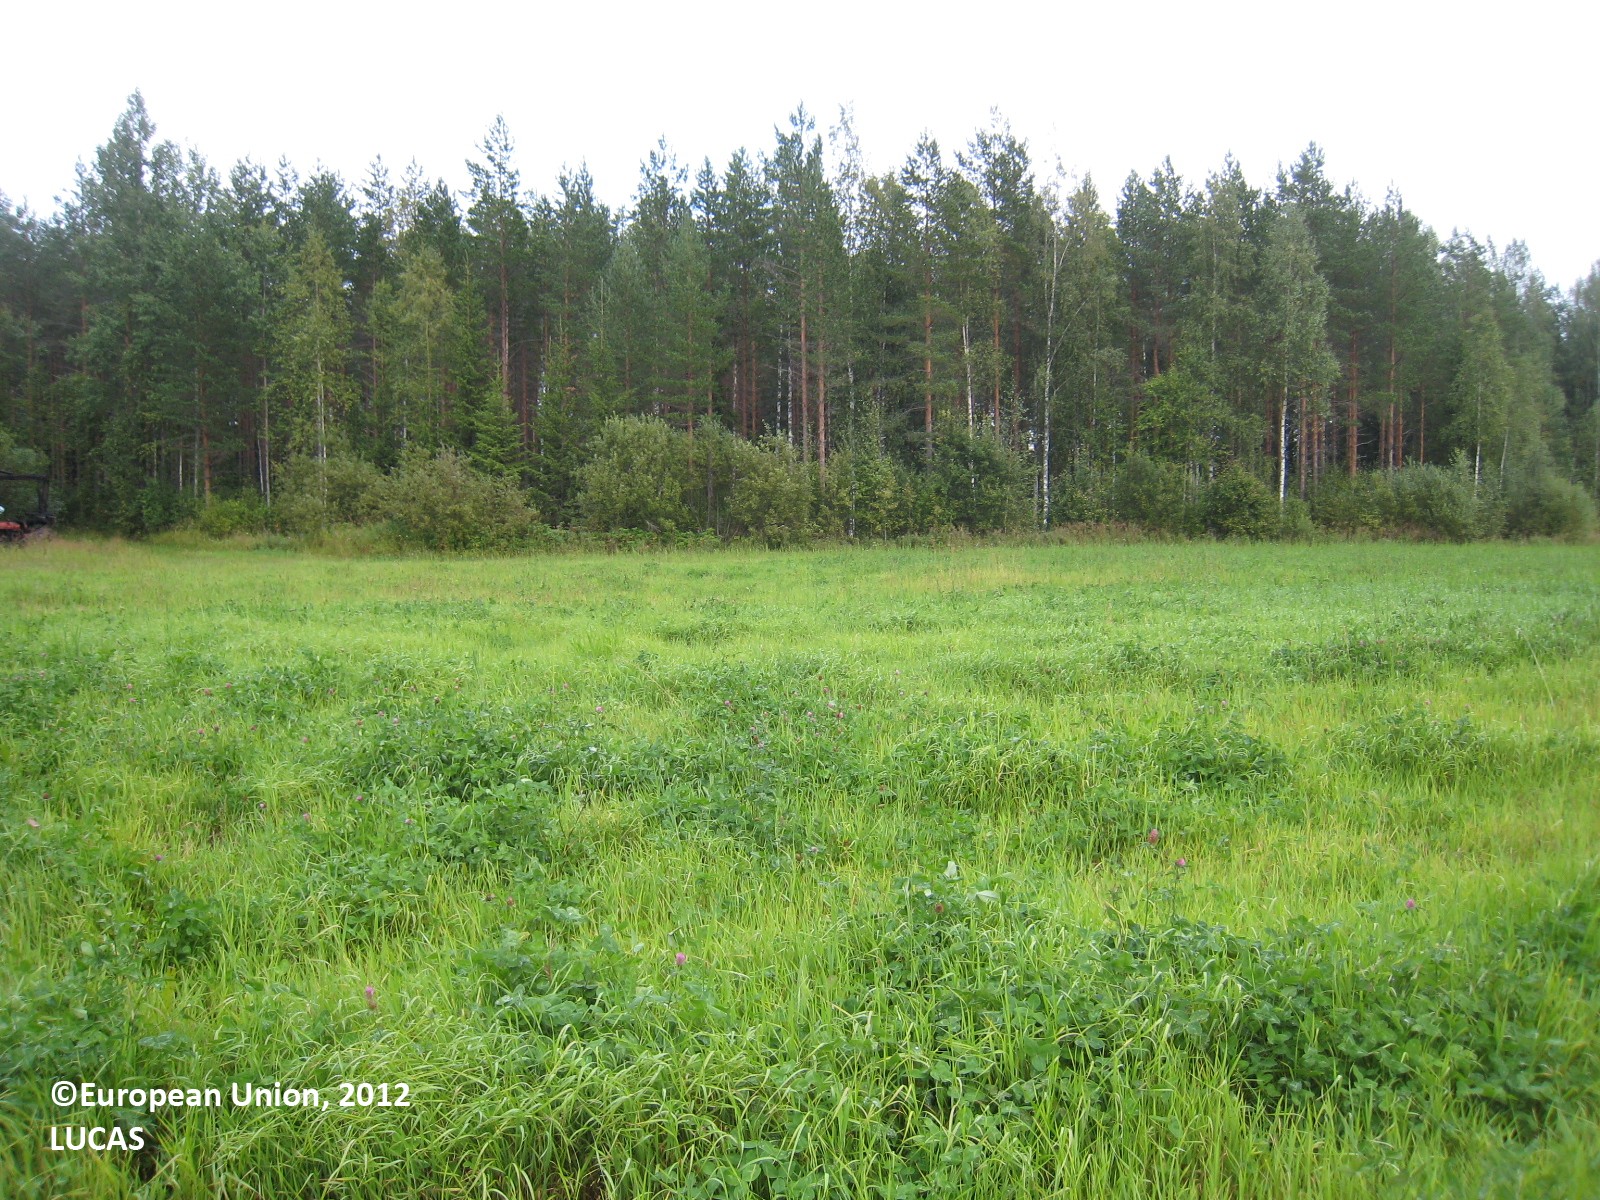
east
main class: Cropland
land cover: Temporary grasslands
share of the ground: > 75 %
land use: Agriculture (excluding fallow land and kitchen gardens)
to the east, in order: Temporary grasslands; Shruby margins; Abandoned hedges; Ditches and canals; Other mixed woodland; Pine dominated coniferous woodland; Other mixed woodland; Ditches and canals; Other mixed woodland; Ditches and canals; Pine dominated mixed woodland; Ditches and canals; Pine dominated mixed woodland; Ditches and canals; Pine dominated mixed woodland
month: August
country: FI
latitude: 61.8775
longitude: 26.1664
